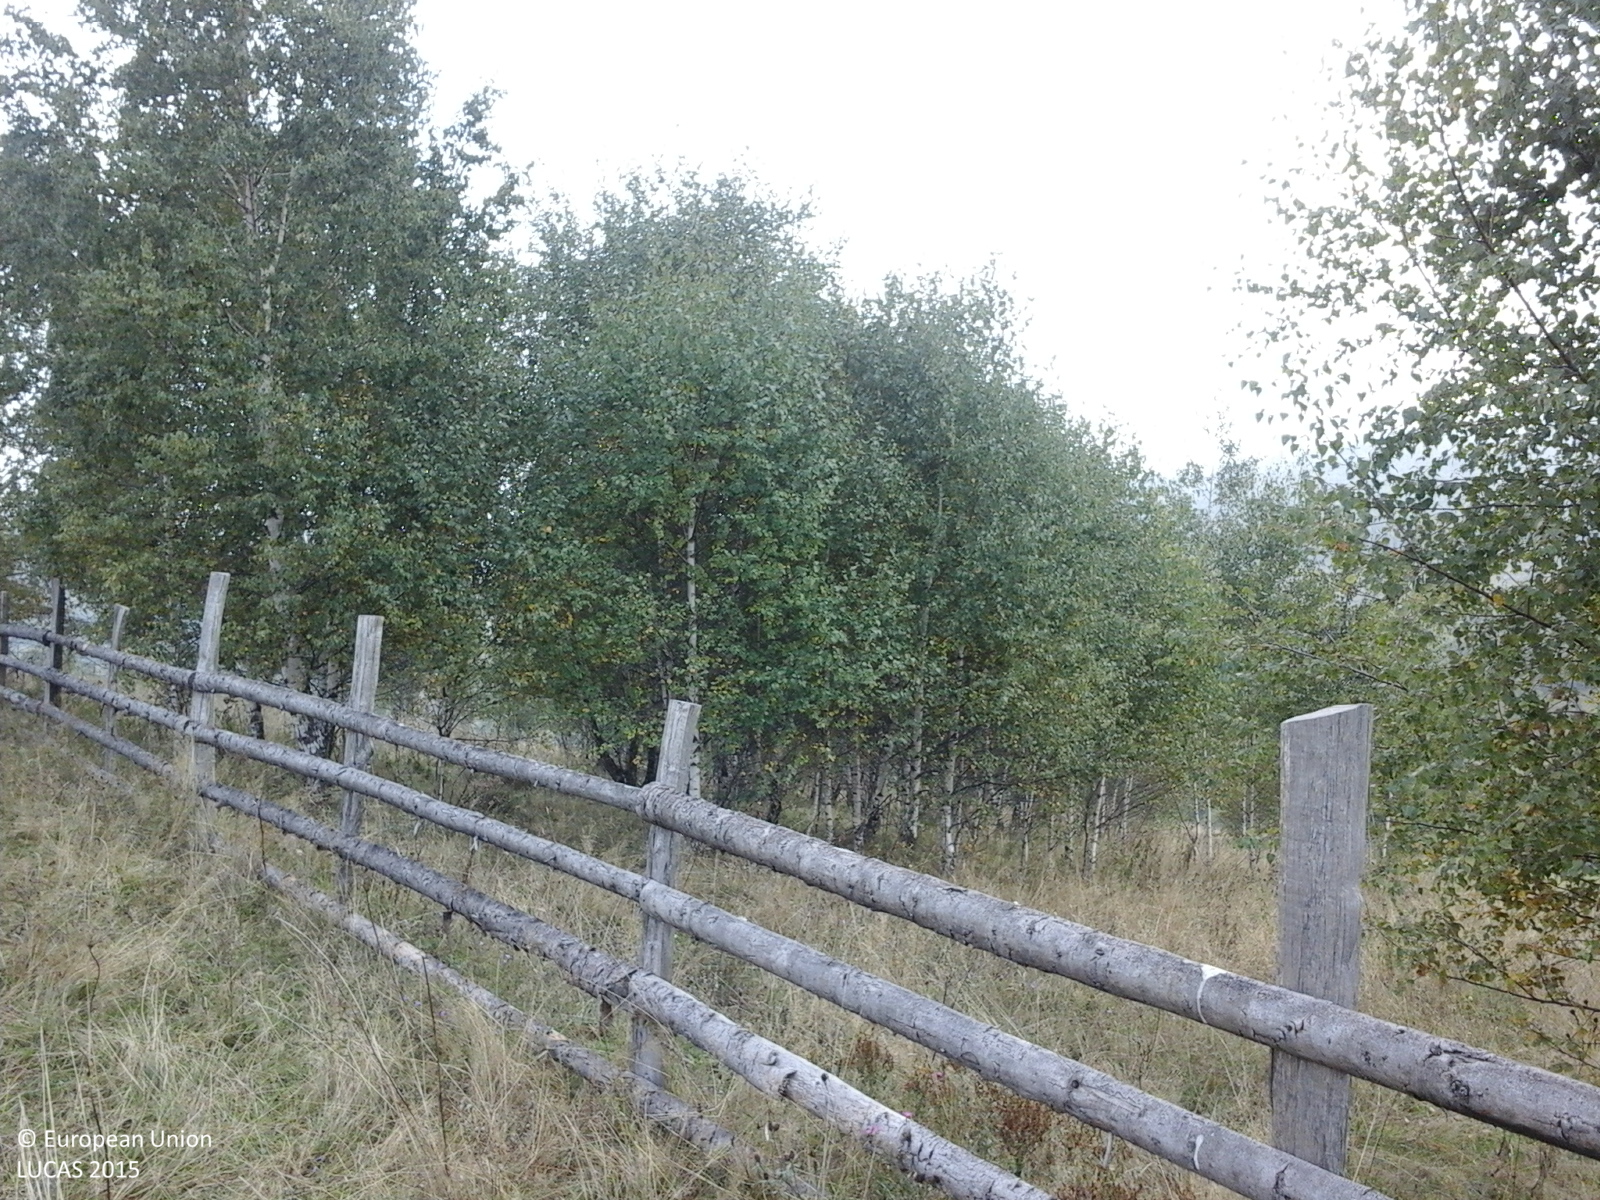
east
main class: Grassland
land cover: Grassland without tree/shrub cover
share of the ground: > 75 %
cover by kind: herbaceous plants 100 %
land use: Agriculture (excluding fallow land and kitchen gardens)
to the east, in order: Grassland without tree/shrub cover; Fences; Grassland without tree/shrub cover; Artificial constructions in urban areas; Grassland without tree/shrub cover; Broadleaved woodland; Grassland with sparse tree/shrub cover
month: October
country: RO
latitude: 45.7560
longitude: 23.7067
